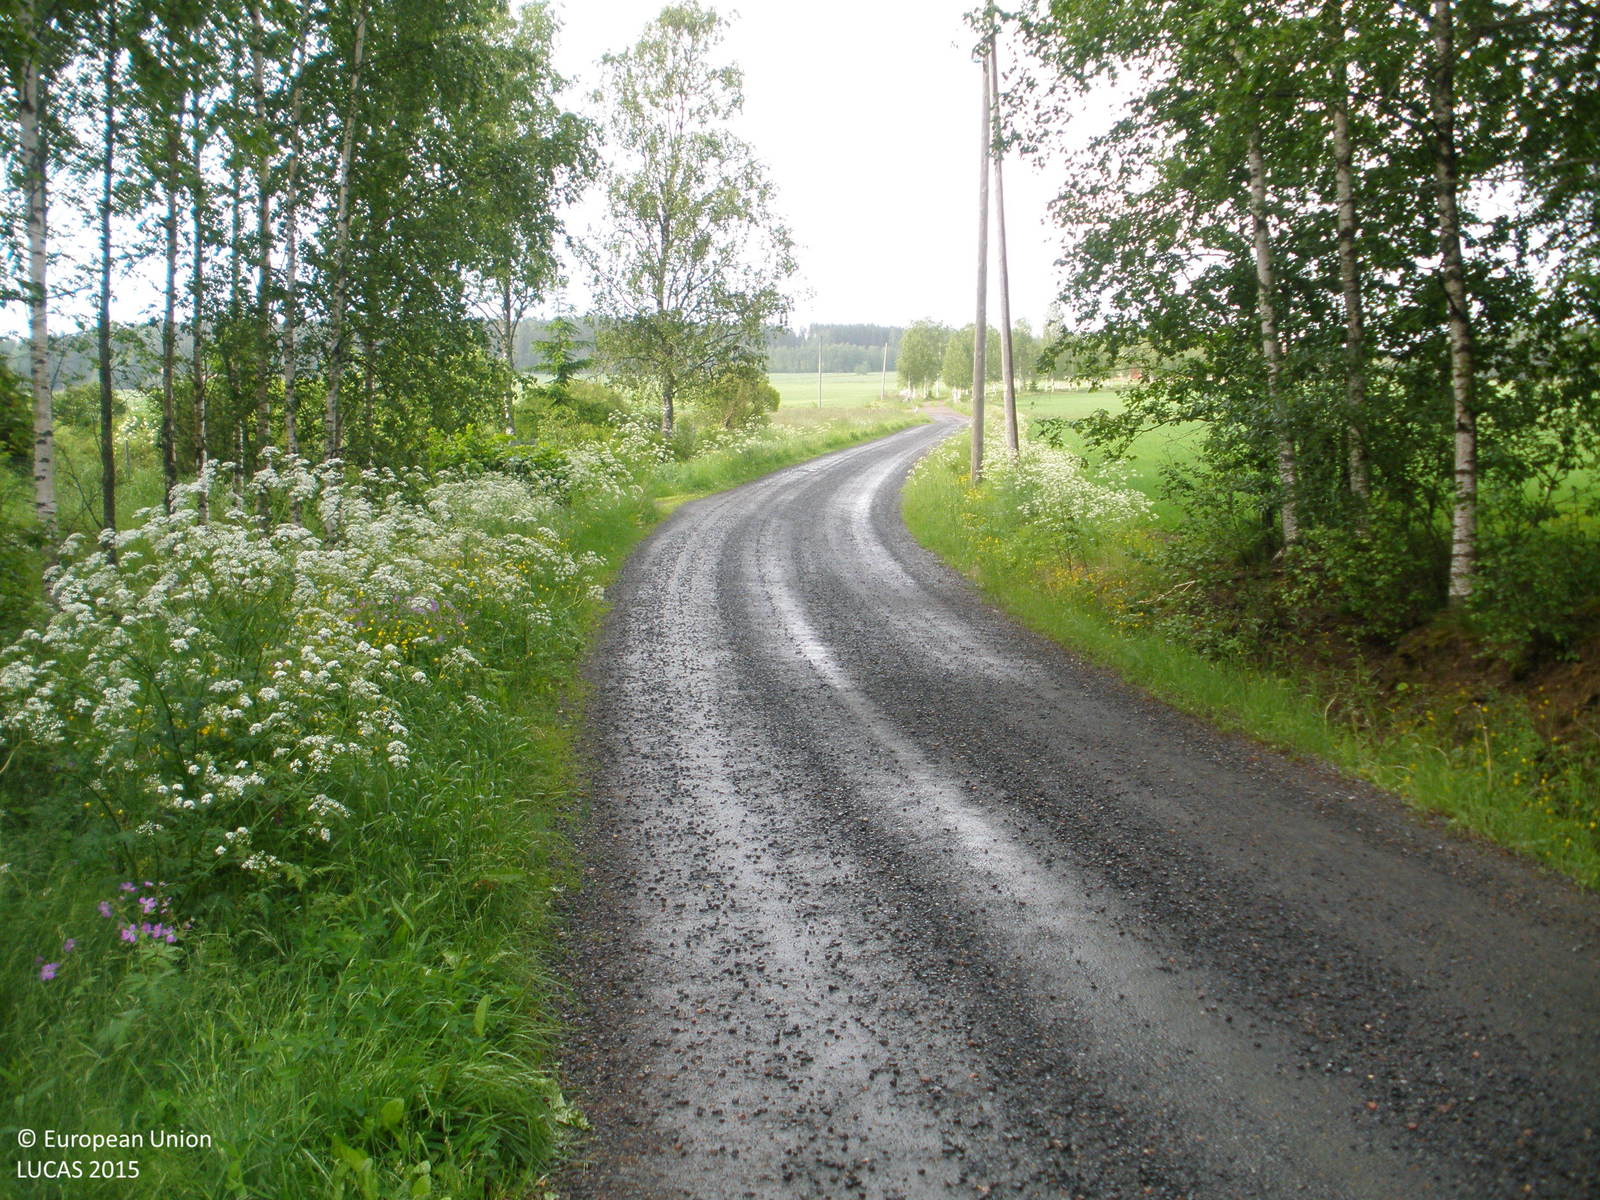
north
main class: Woodland
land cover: Broadleaved woodland
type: non-riverine alder, birch or aspen forest
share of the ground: > 75 %
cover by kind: broadleaved forest trees 80 %, herbaceous plants 15 %, shrubs 5 %
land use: Forestry
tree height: > 5 m
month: June
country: FI
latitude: 60.8847
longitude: 23.4779
